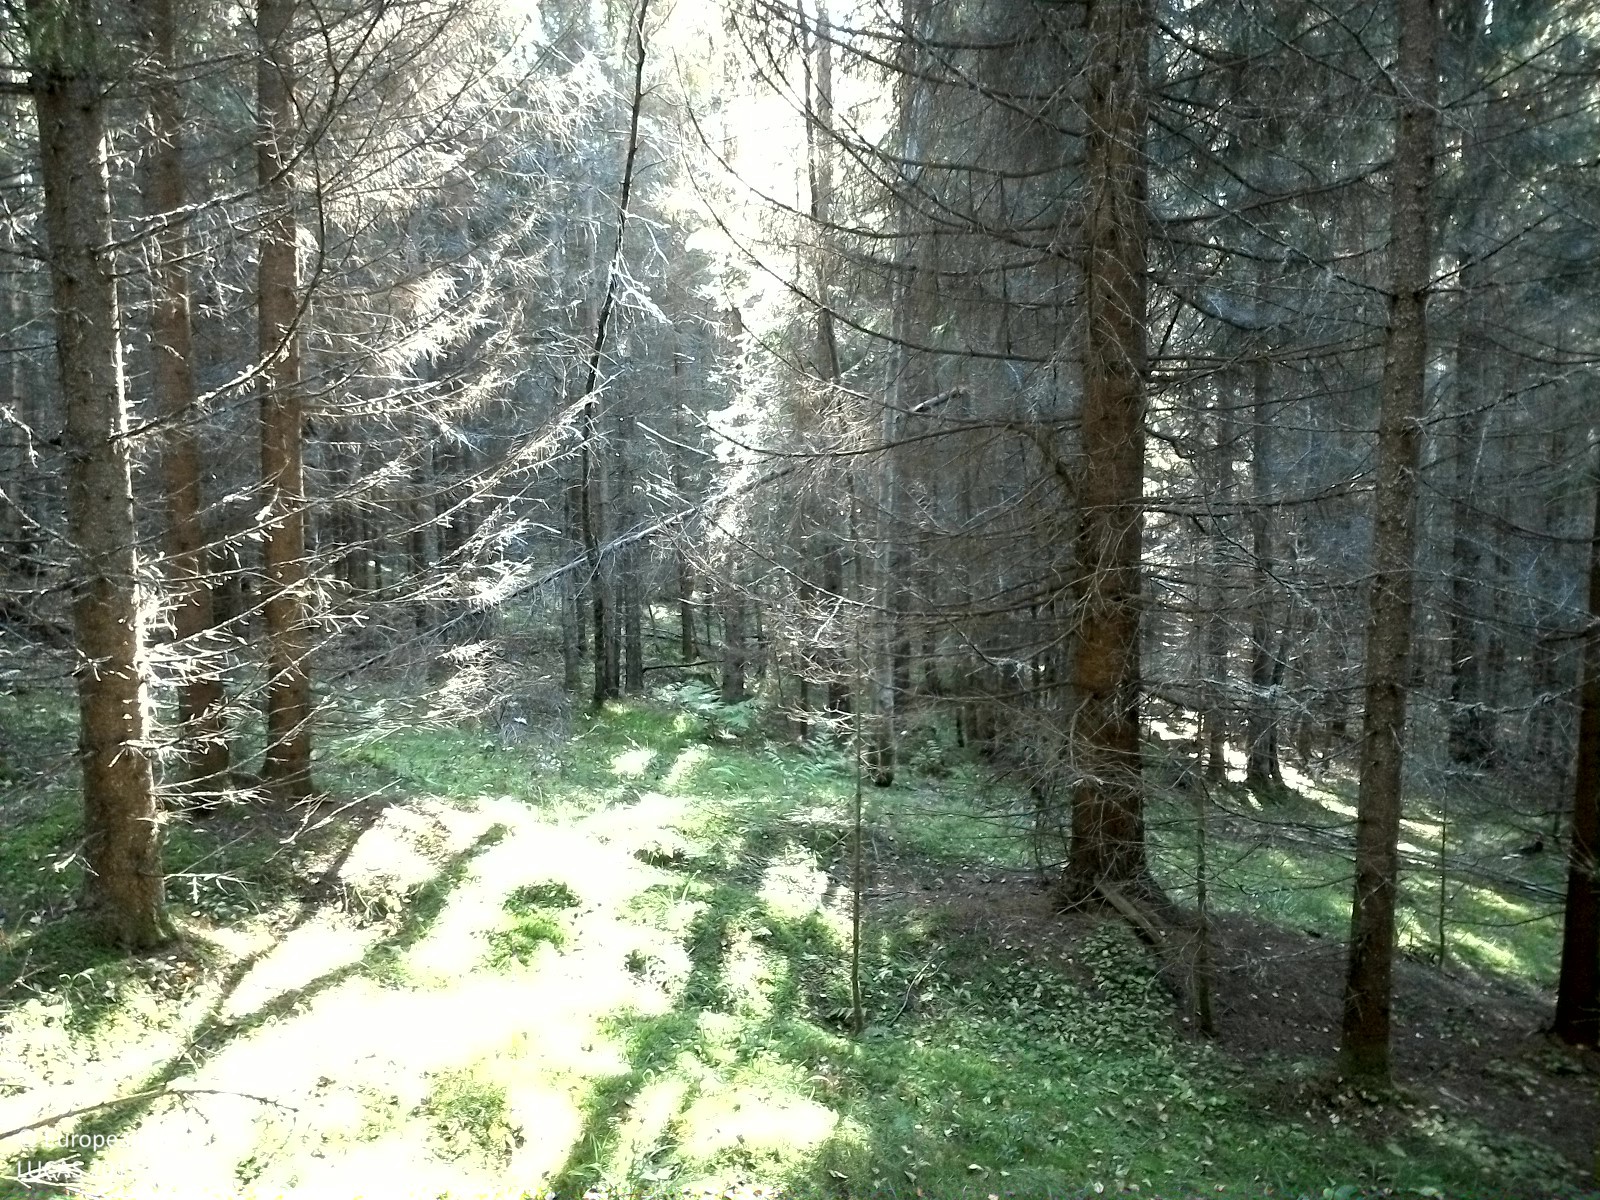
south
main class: Woodland
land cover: Spruce dominated coniferous woodland
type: boreal forest
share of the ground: > 75 %
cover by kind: coniferous forest trees 80 %, broadleaved forest trees 10 %, shrubs 10 %
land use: Forestry
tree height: > 5 m
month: September
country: SE
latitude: 62.2946
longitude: 17.2109
